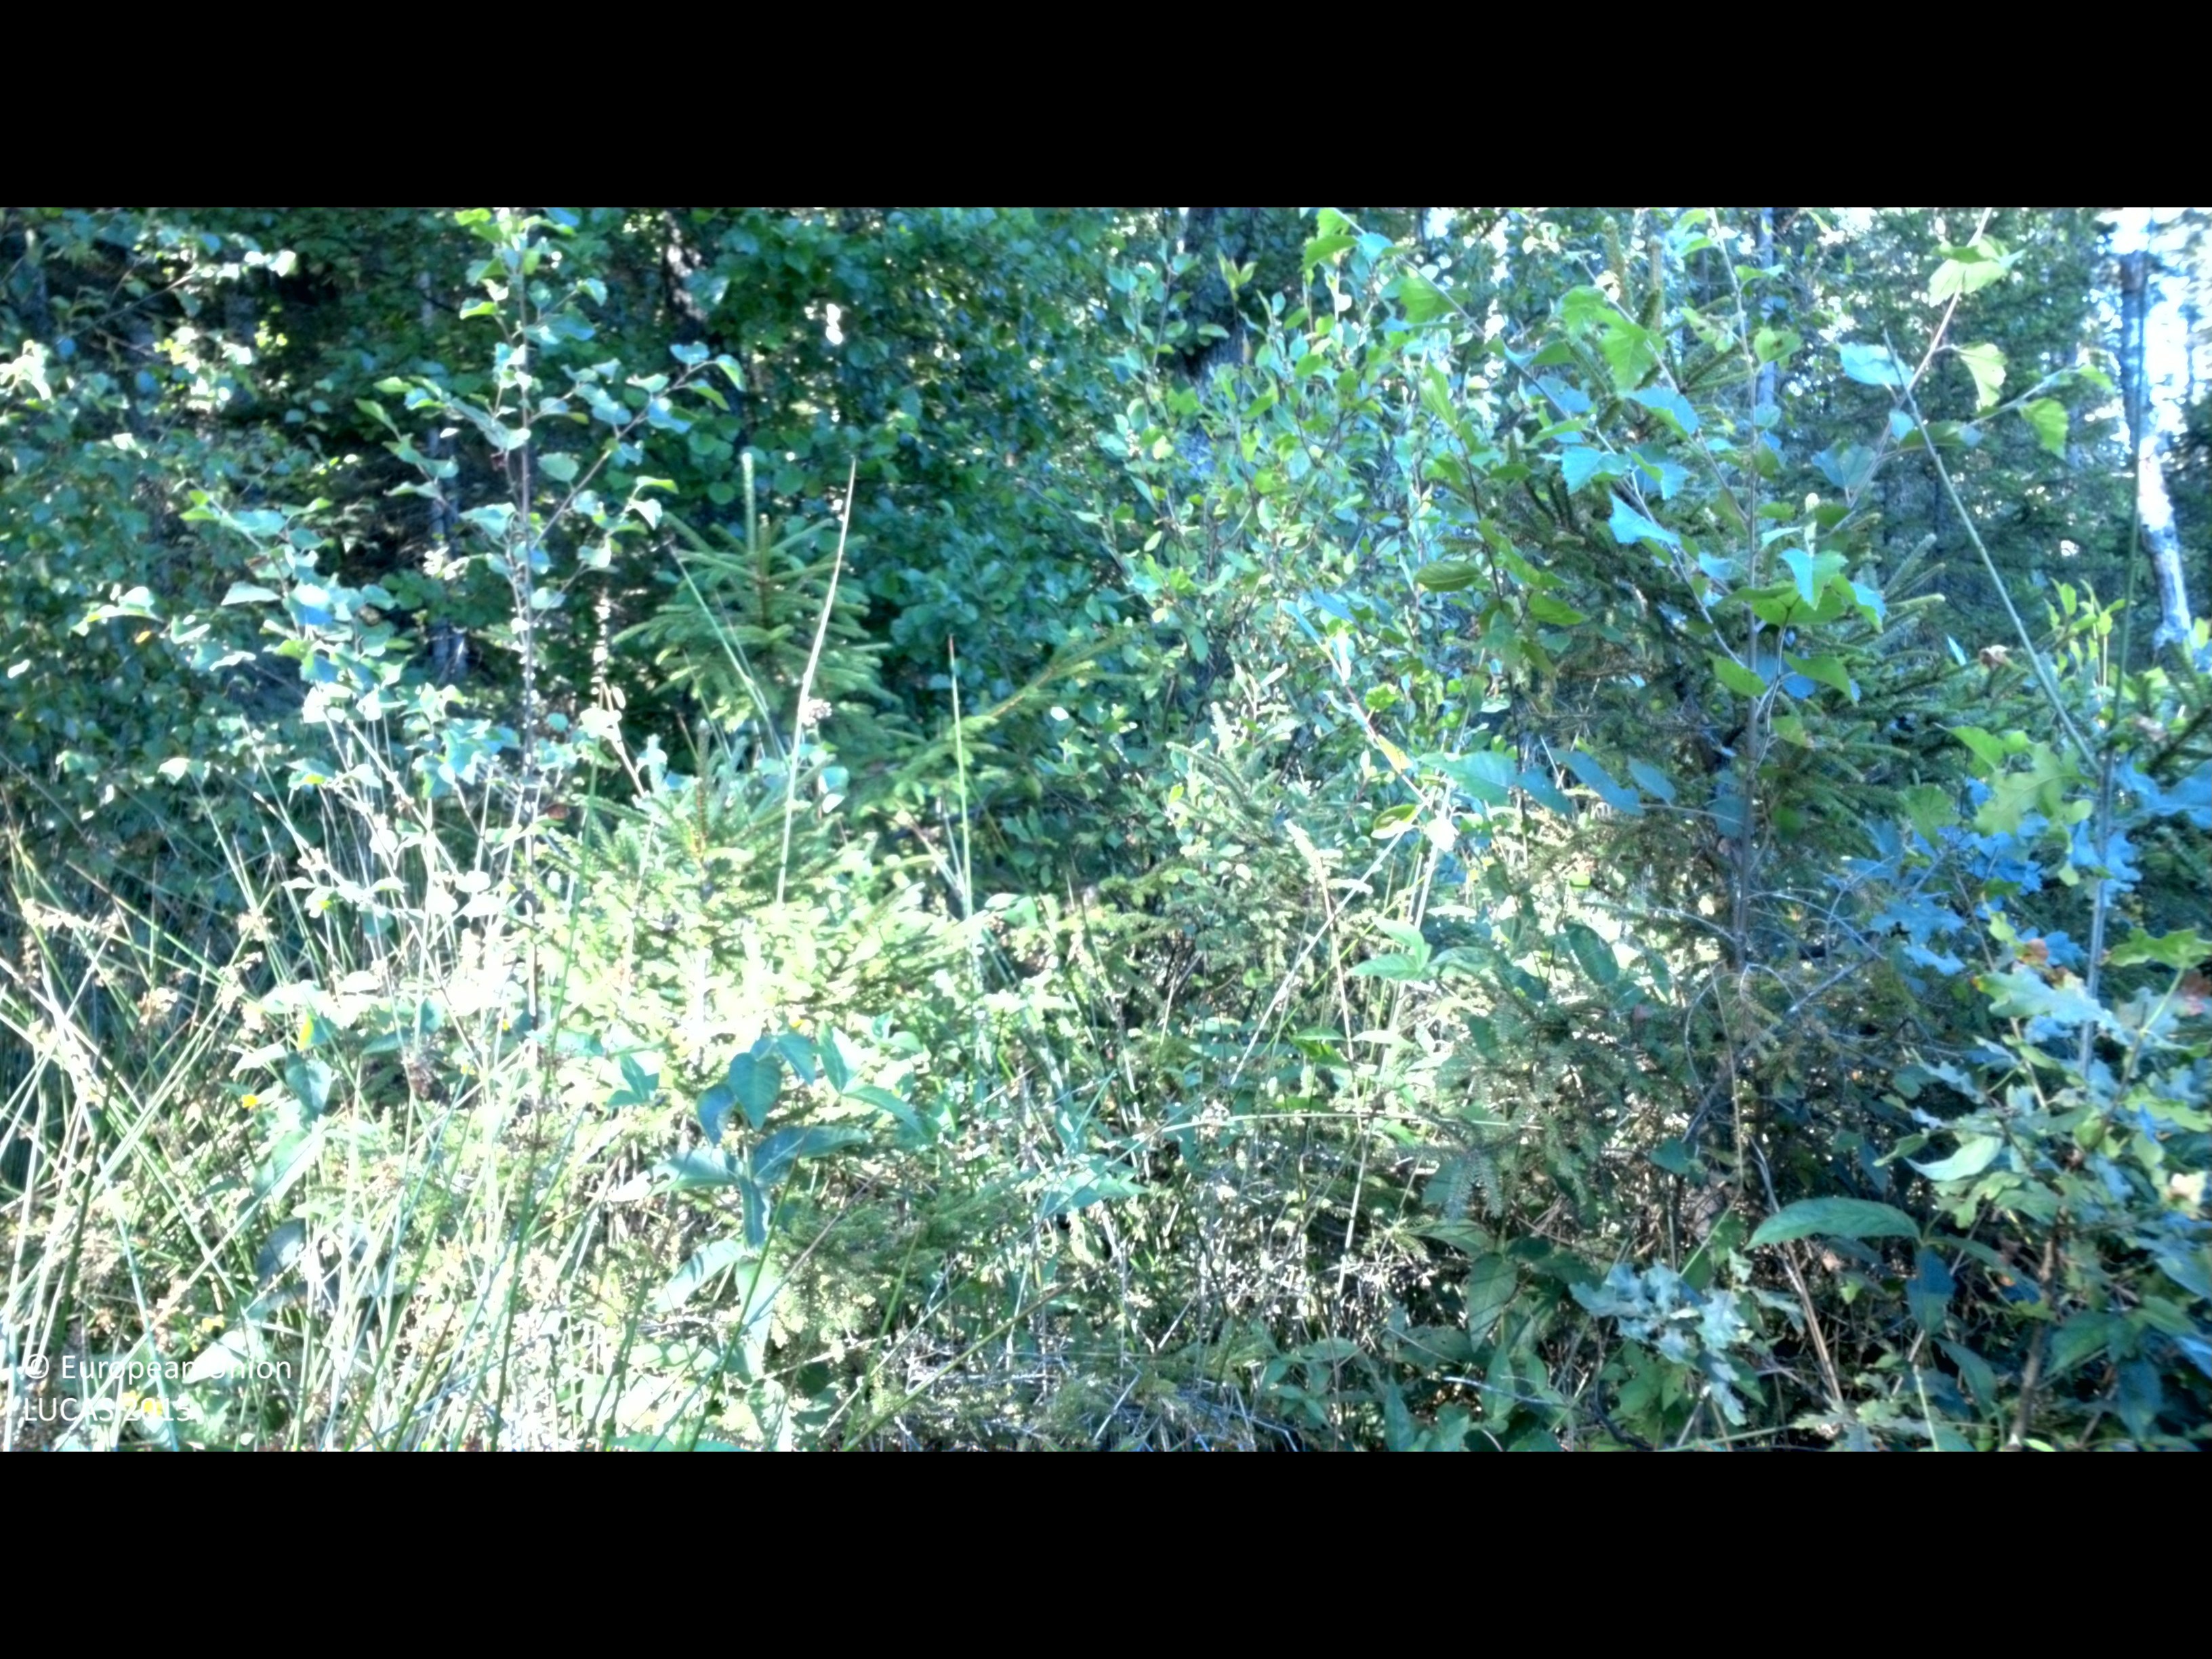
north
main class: Woodland
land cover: Spruce dominated mixed woodland
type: hemiboreal forest and nemoral coniferous forest and mixed broadleaved-coniferous forest
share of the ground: > 75 %
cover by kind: coniferous forest trees 50 %, broadleaved forest trees 25 %, herbaceous plants 20 %, shrubs 5 %
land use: Forestry
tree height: > 5 m
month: August
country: SE
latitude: 56.2979
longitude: 15.2183
